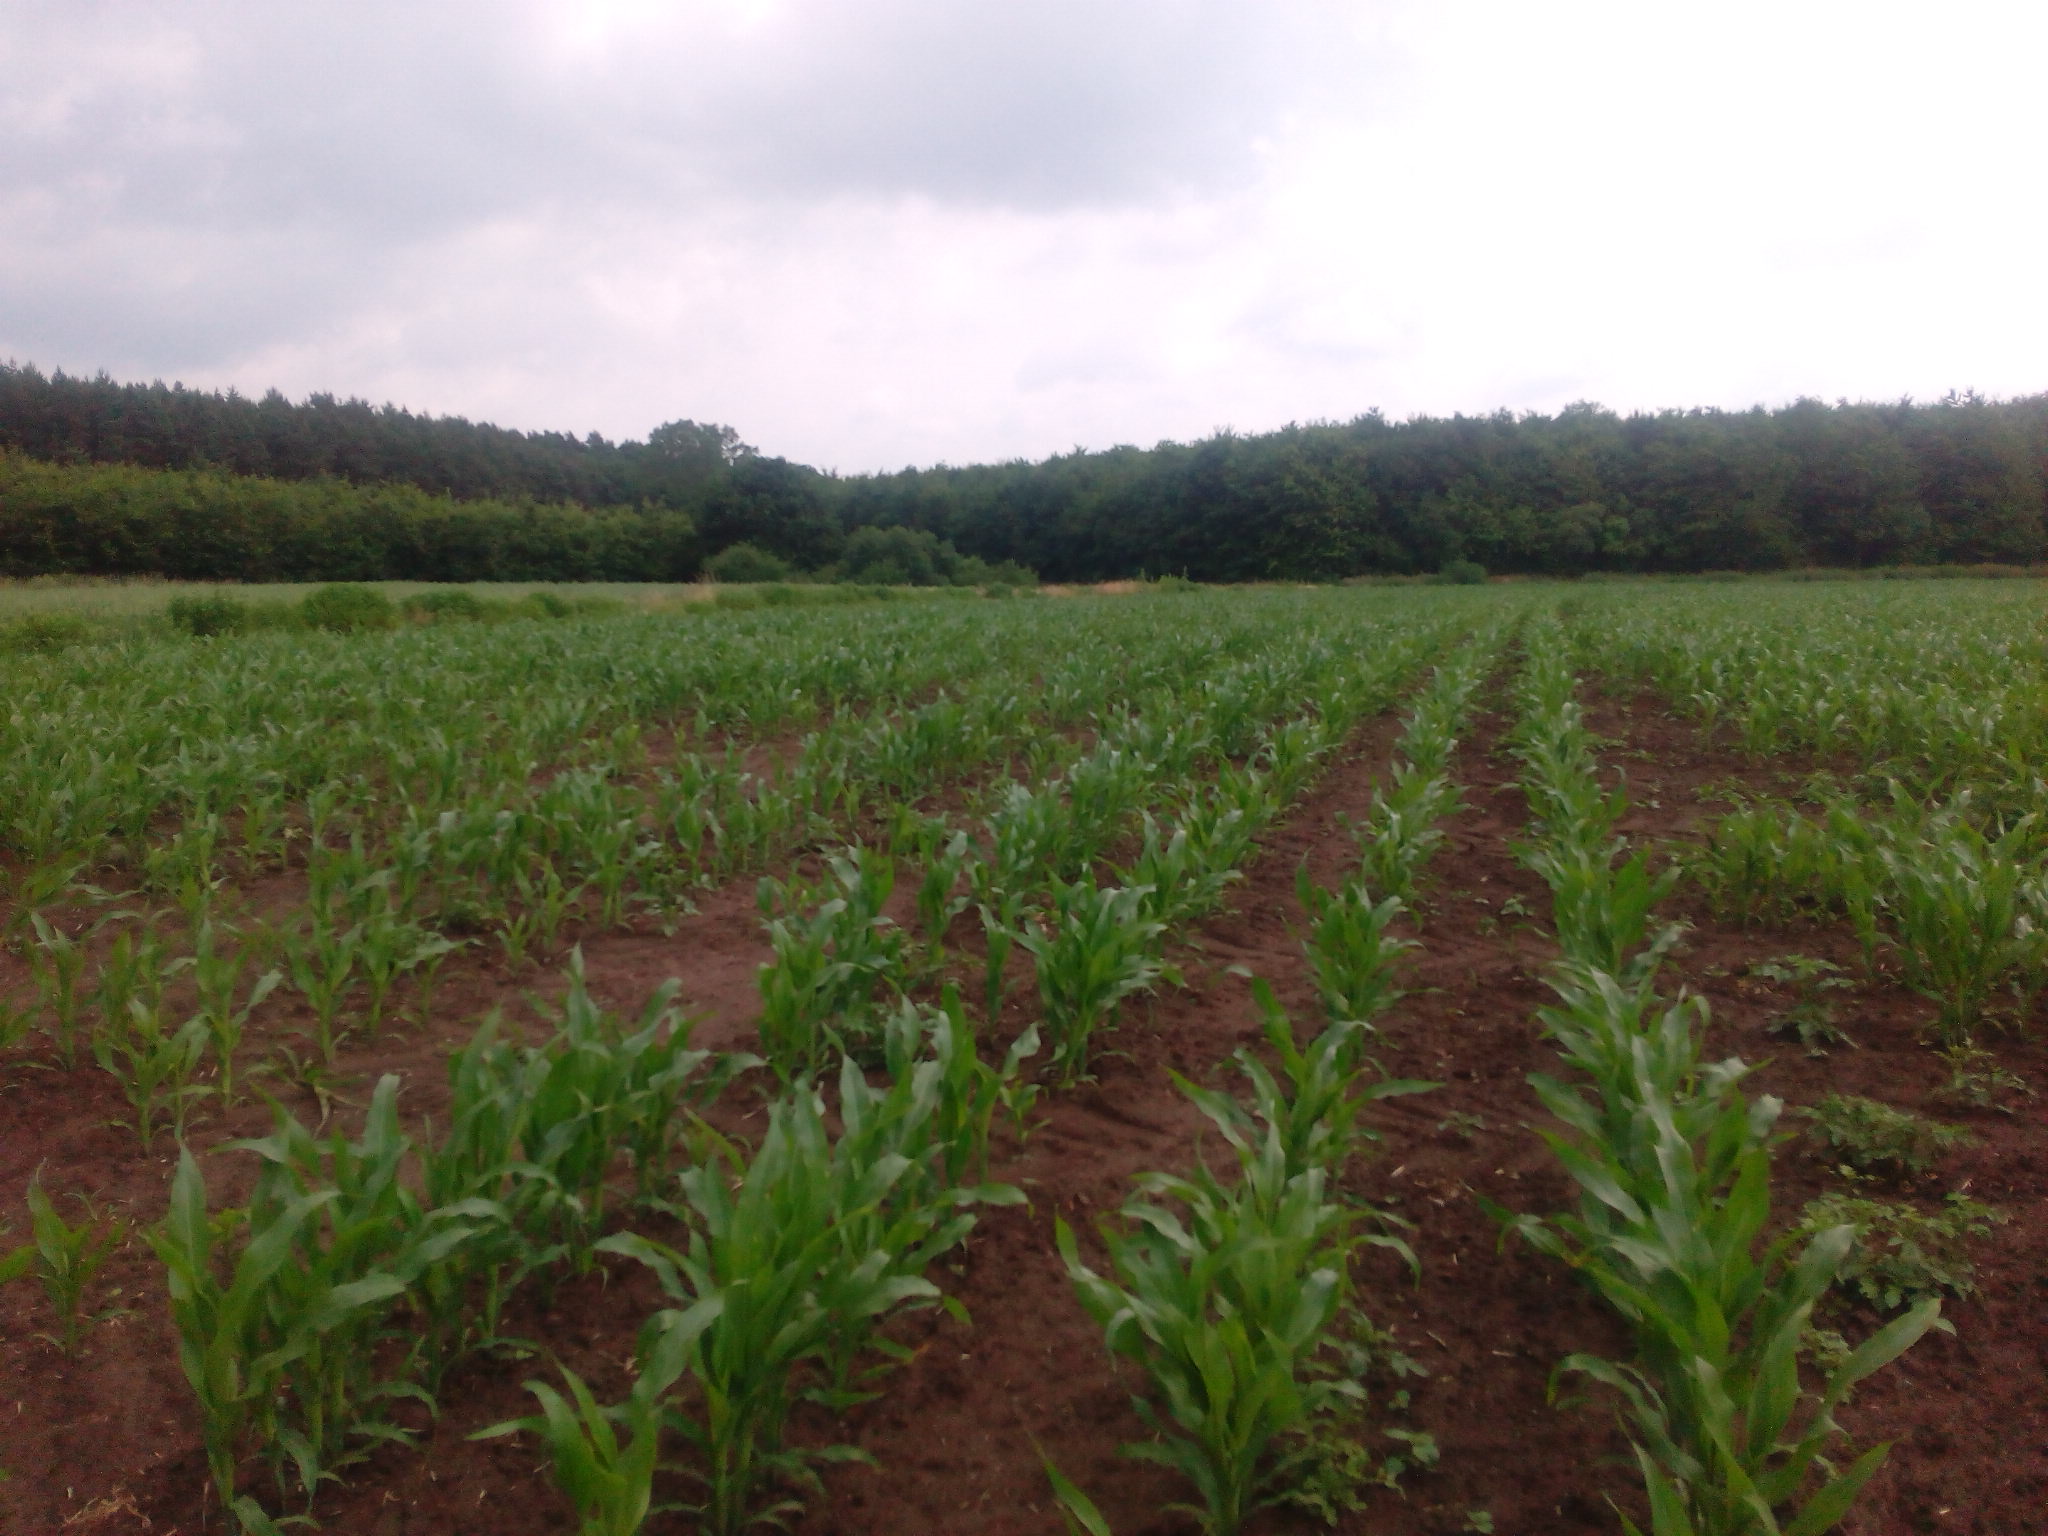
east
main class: Cropland
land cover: Maize
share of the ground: 50 - 75 %
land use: Agriculture (excluding fallow land and kitchen gardens)
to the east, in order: Maize; Grassland without tree/shrub cover; Tracks; Grass margins; Broadleaved woodland
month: June
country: DE
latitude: 52.6464
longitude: 9.6011
